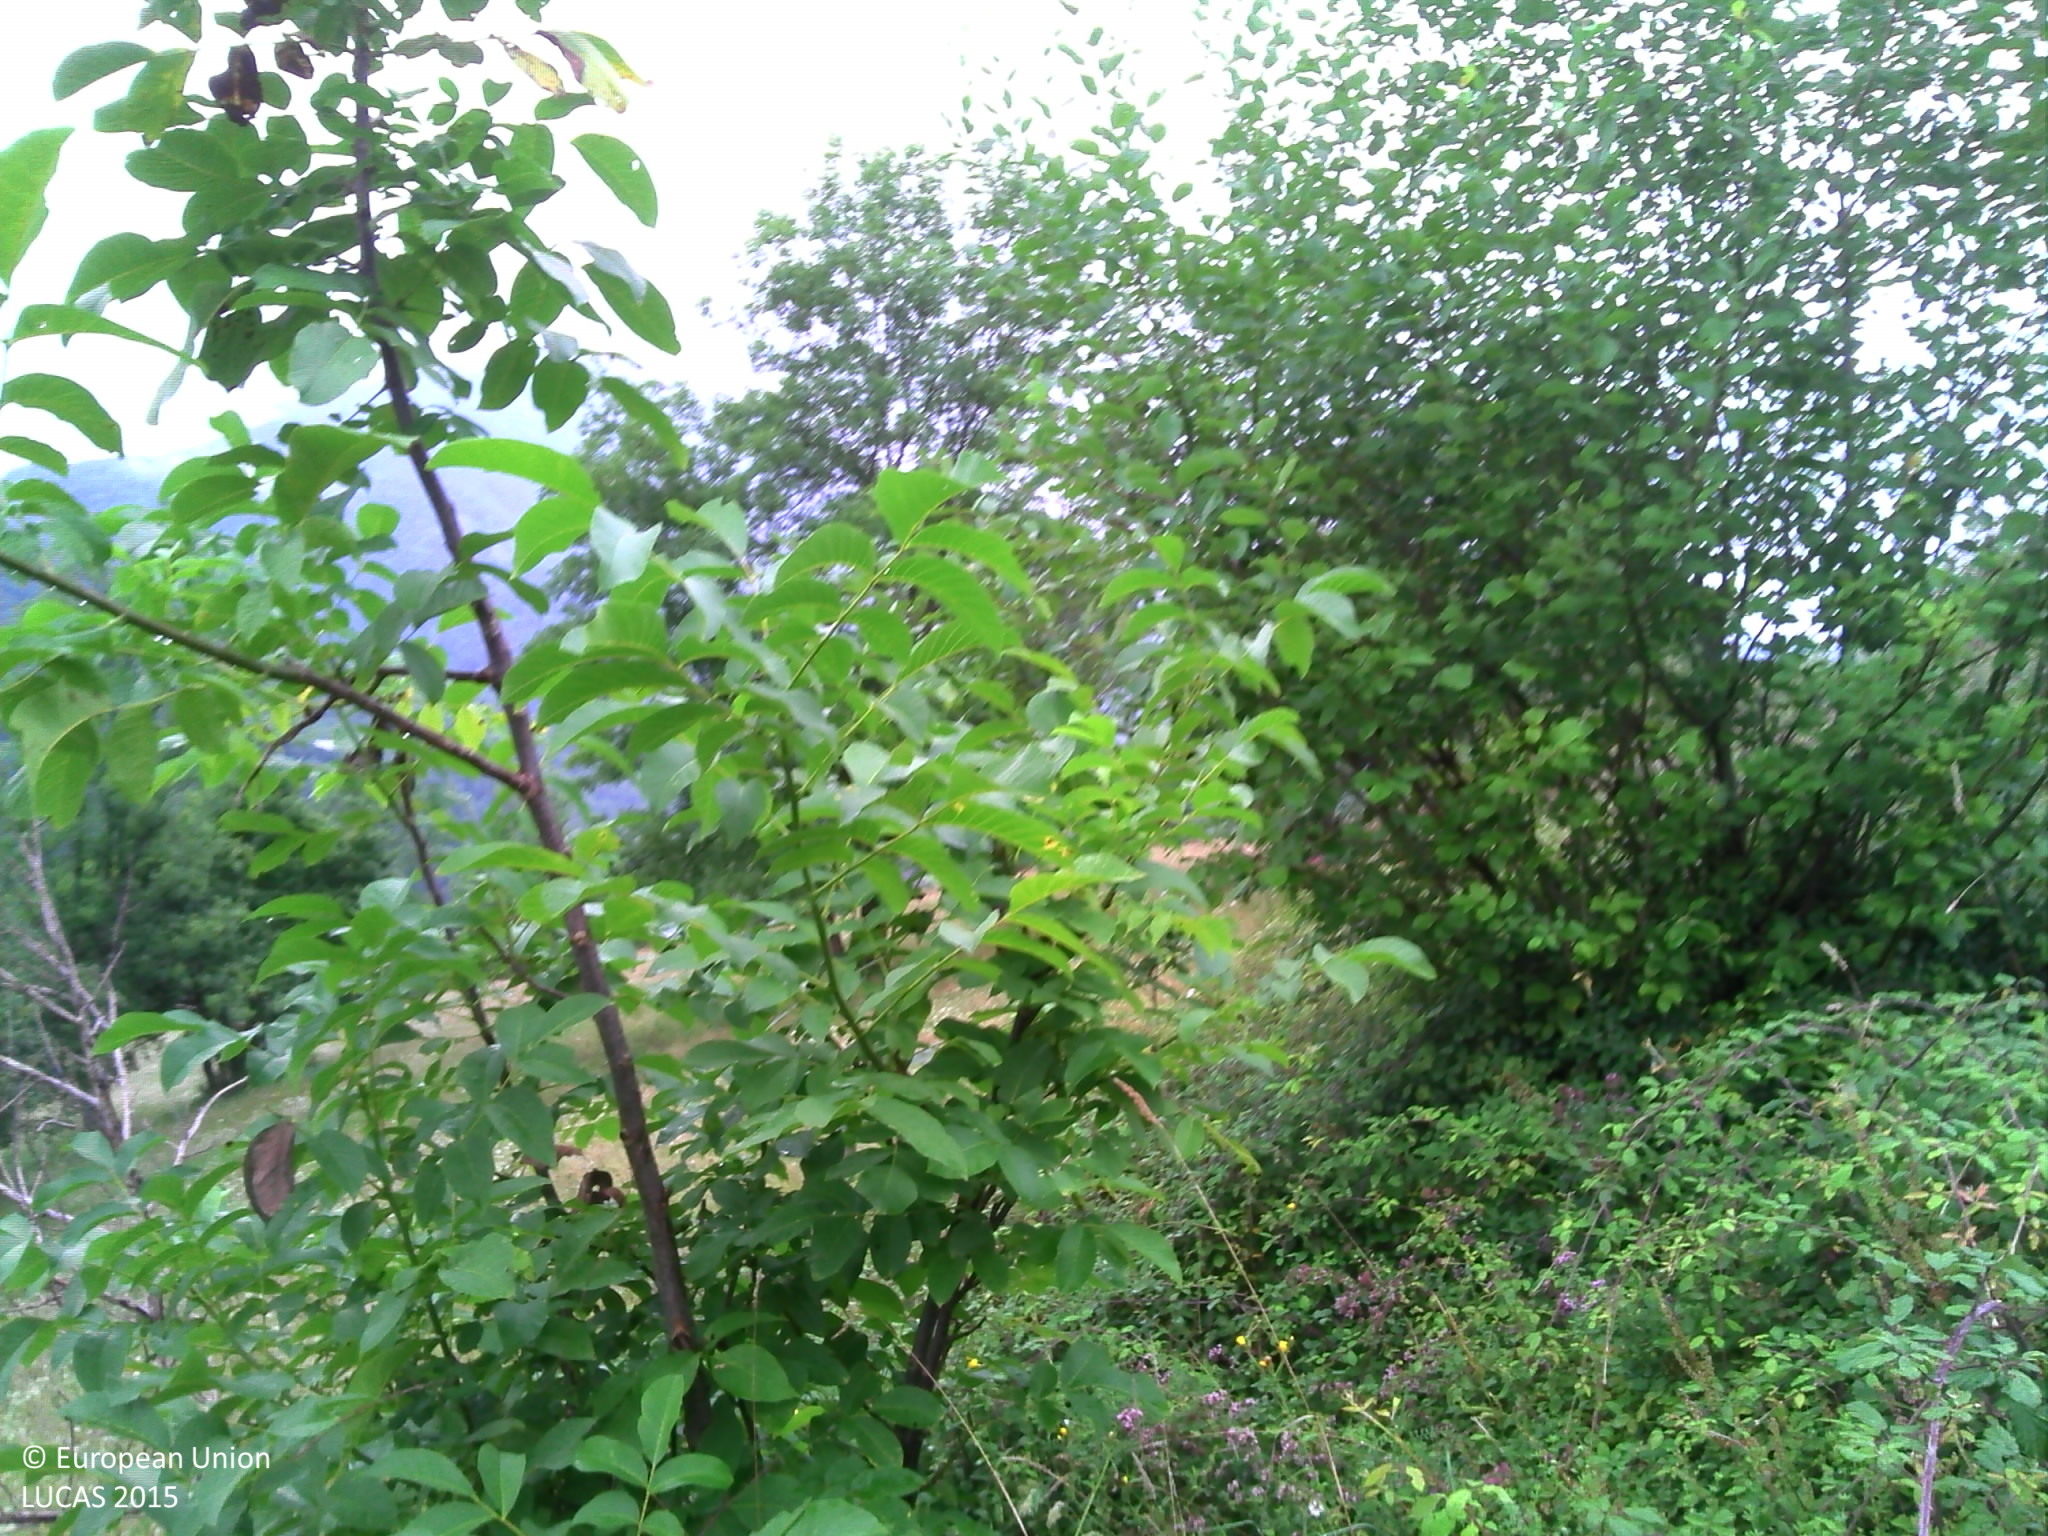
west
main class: Grassland
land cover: Spontaneously vegetated surfaces
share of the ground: > 75 %
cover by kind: herbaceous plants 100 %
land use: Semi-natural and natural areas not in use
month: August
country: FR
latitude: 42.8929
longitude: 1.0535
